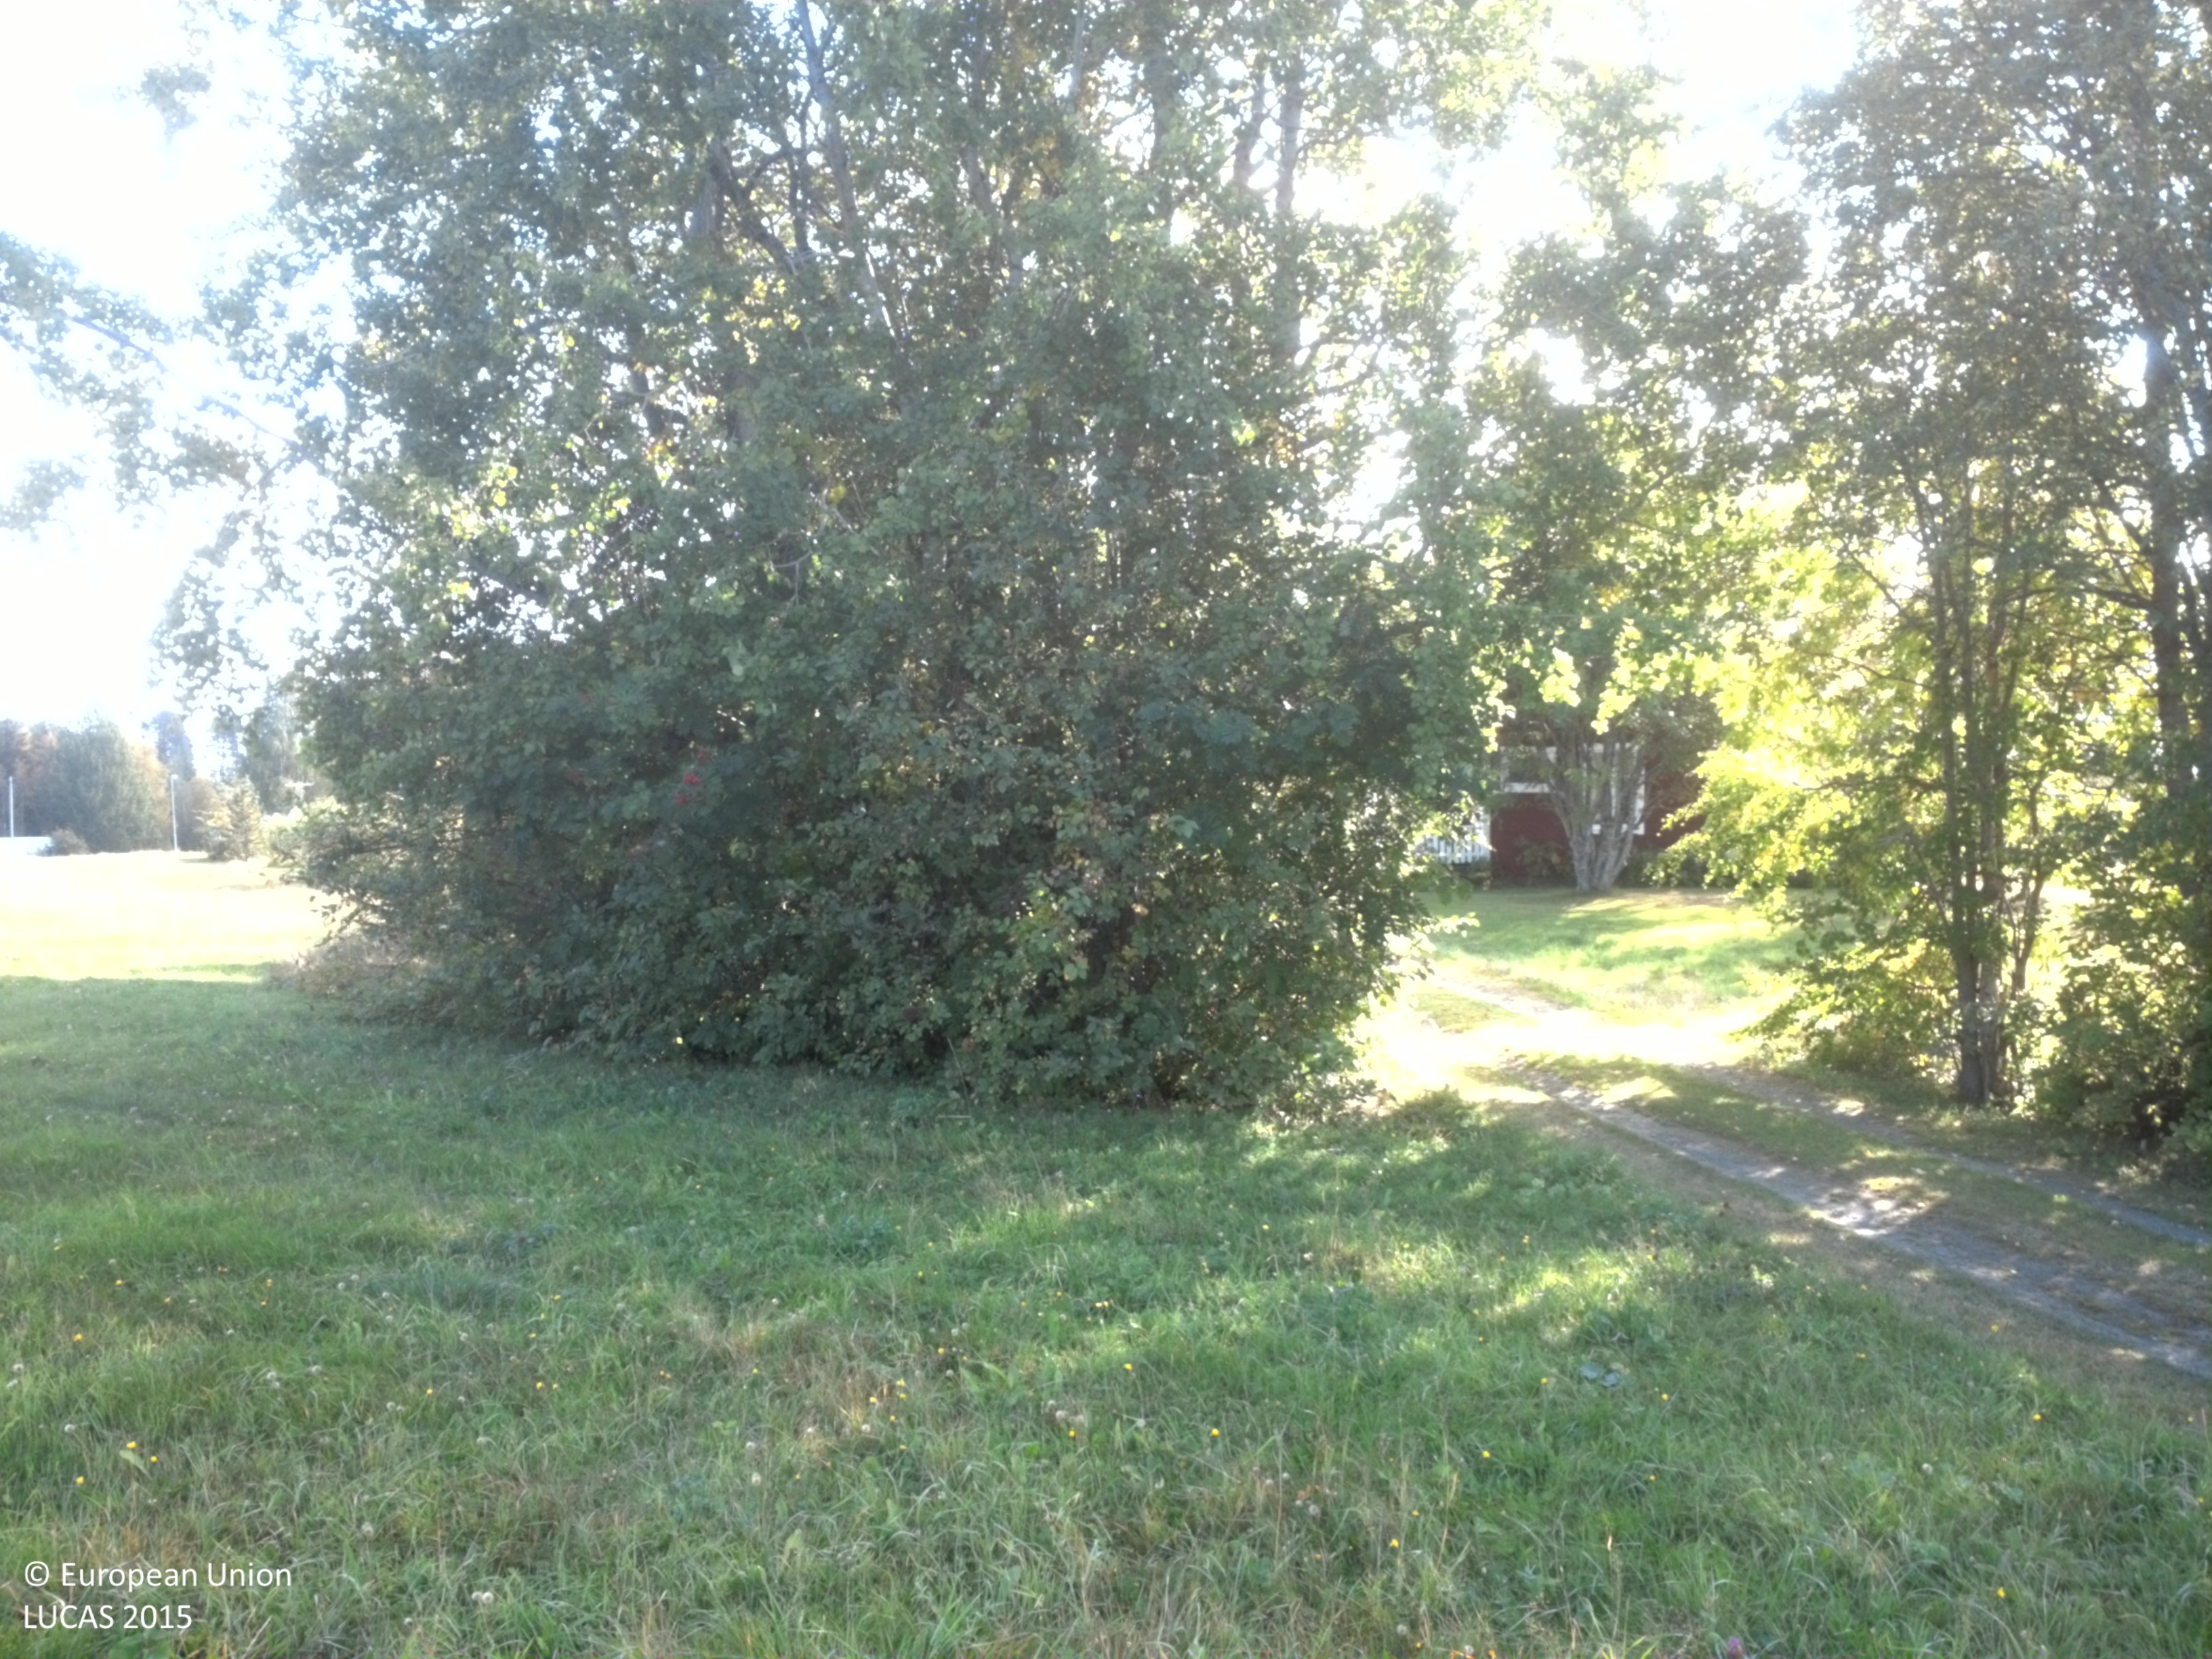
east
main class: Grassland
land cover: Grassland without tree/shrub cover
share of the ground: > 75 %
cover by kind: herbaceous plants 100 %
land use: Agriculture (excluding fallow land and kitchen gardens)
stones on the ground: 10 - 25 %
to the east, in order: Grassland without tree/shrub cover; Broadleaved woodland; Grassland without tree/shrub cover; Broadleaved woodland; Tracks; Grassland without tree/shrub cover; Artificial constructions in urban areas; Grassland without tree/shrub cover; Electric lines; Grassland with sparse tree/shrub cover; Paved roads, cycling and walking lanes; Grassland with sparse tree/shrub cover; Pine dominated mixed woodland
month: September
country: SE
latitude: 64.4332
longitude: 19.9220
